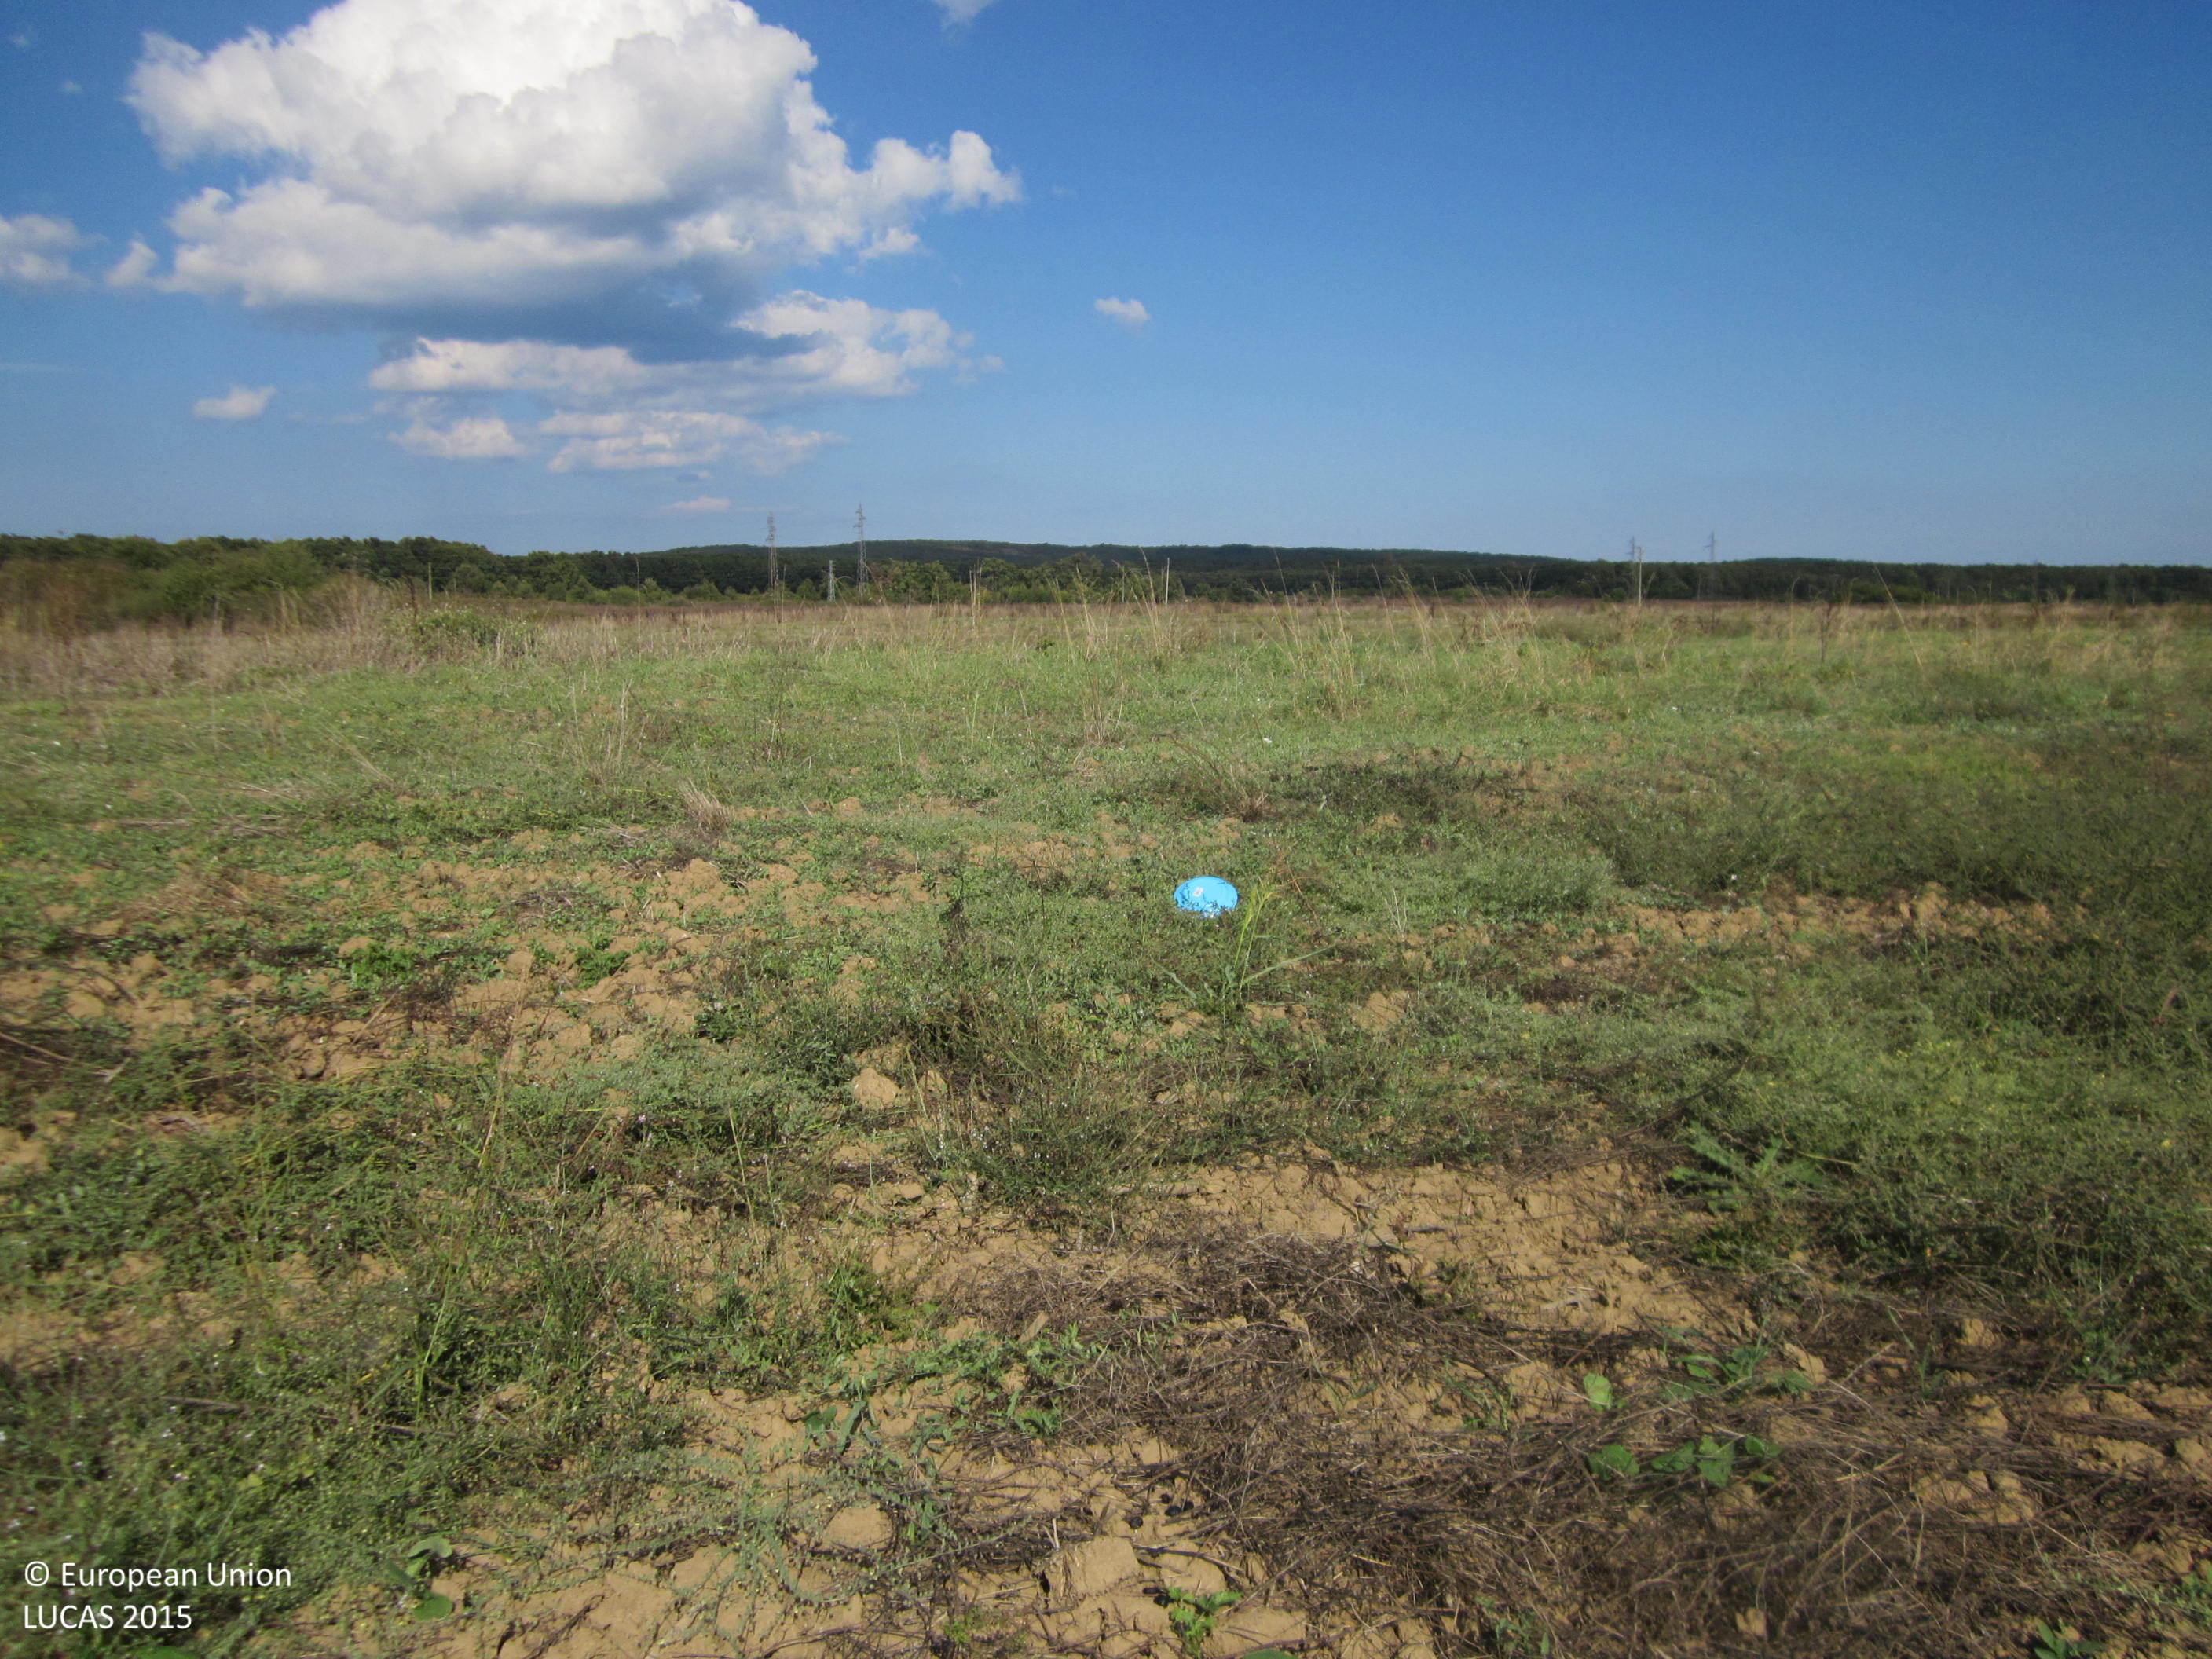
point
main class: Grassland
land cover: Grassland without tree/shrub cover
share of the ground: > 75 %
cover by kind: herbaceous plants 85 %, unconsolidated bare surface 15 %
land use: Agriculture (excluding fallow land and kitchen gardens)
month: September
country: BG
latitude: 42.2634
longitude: 27.6857
